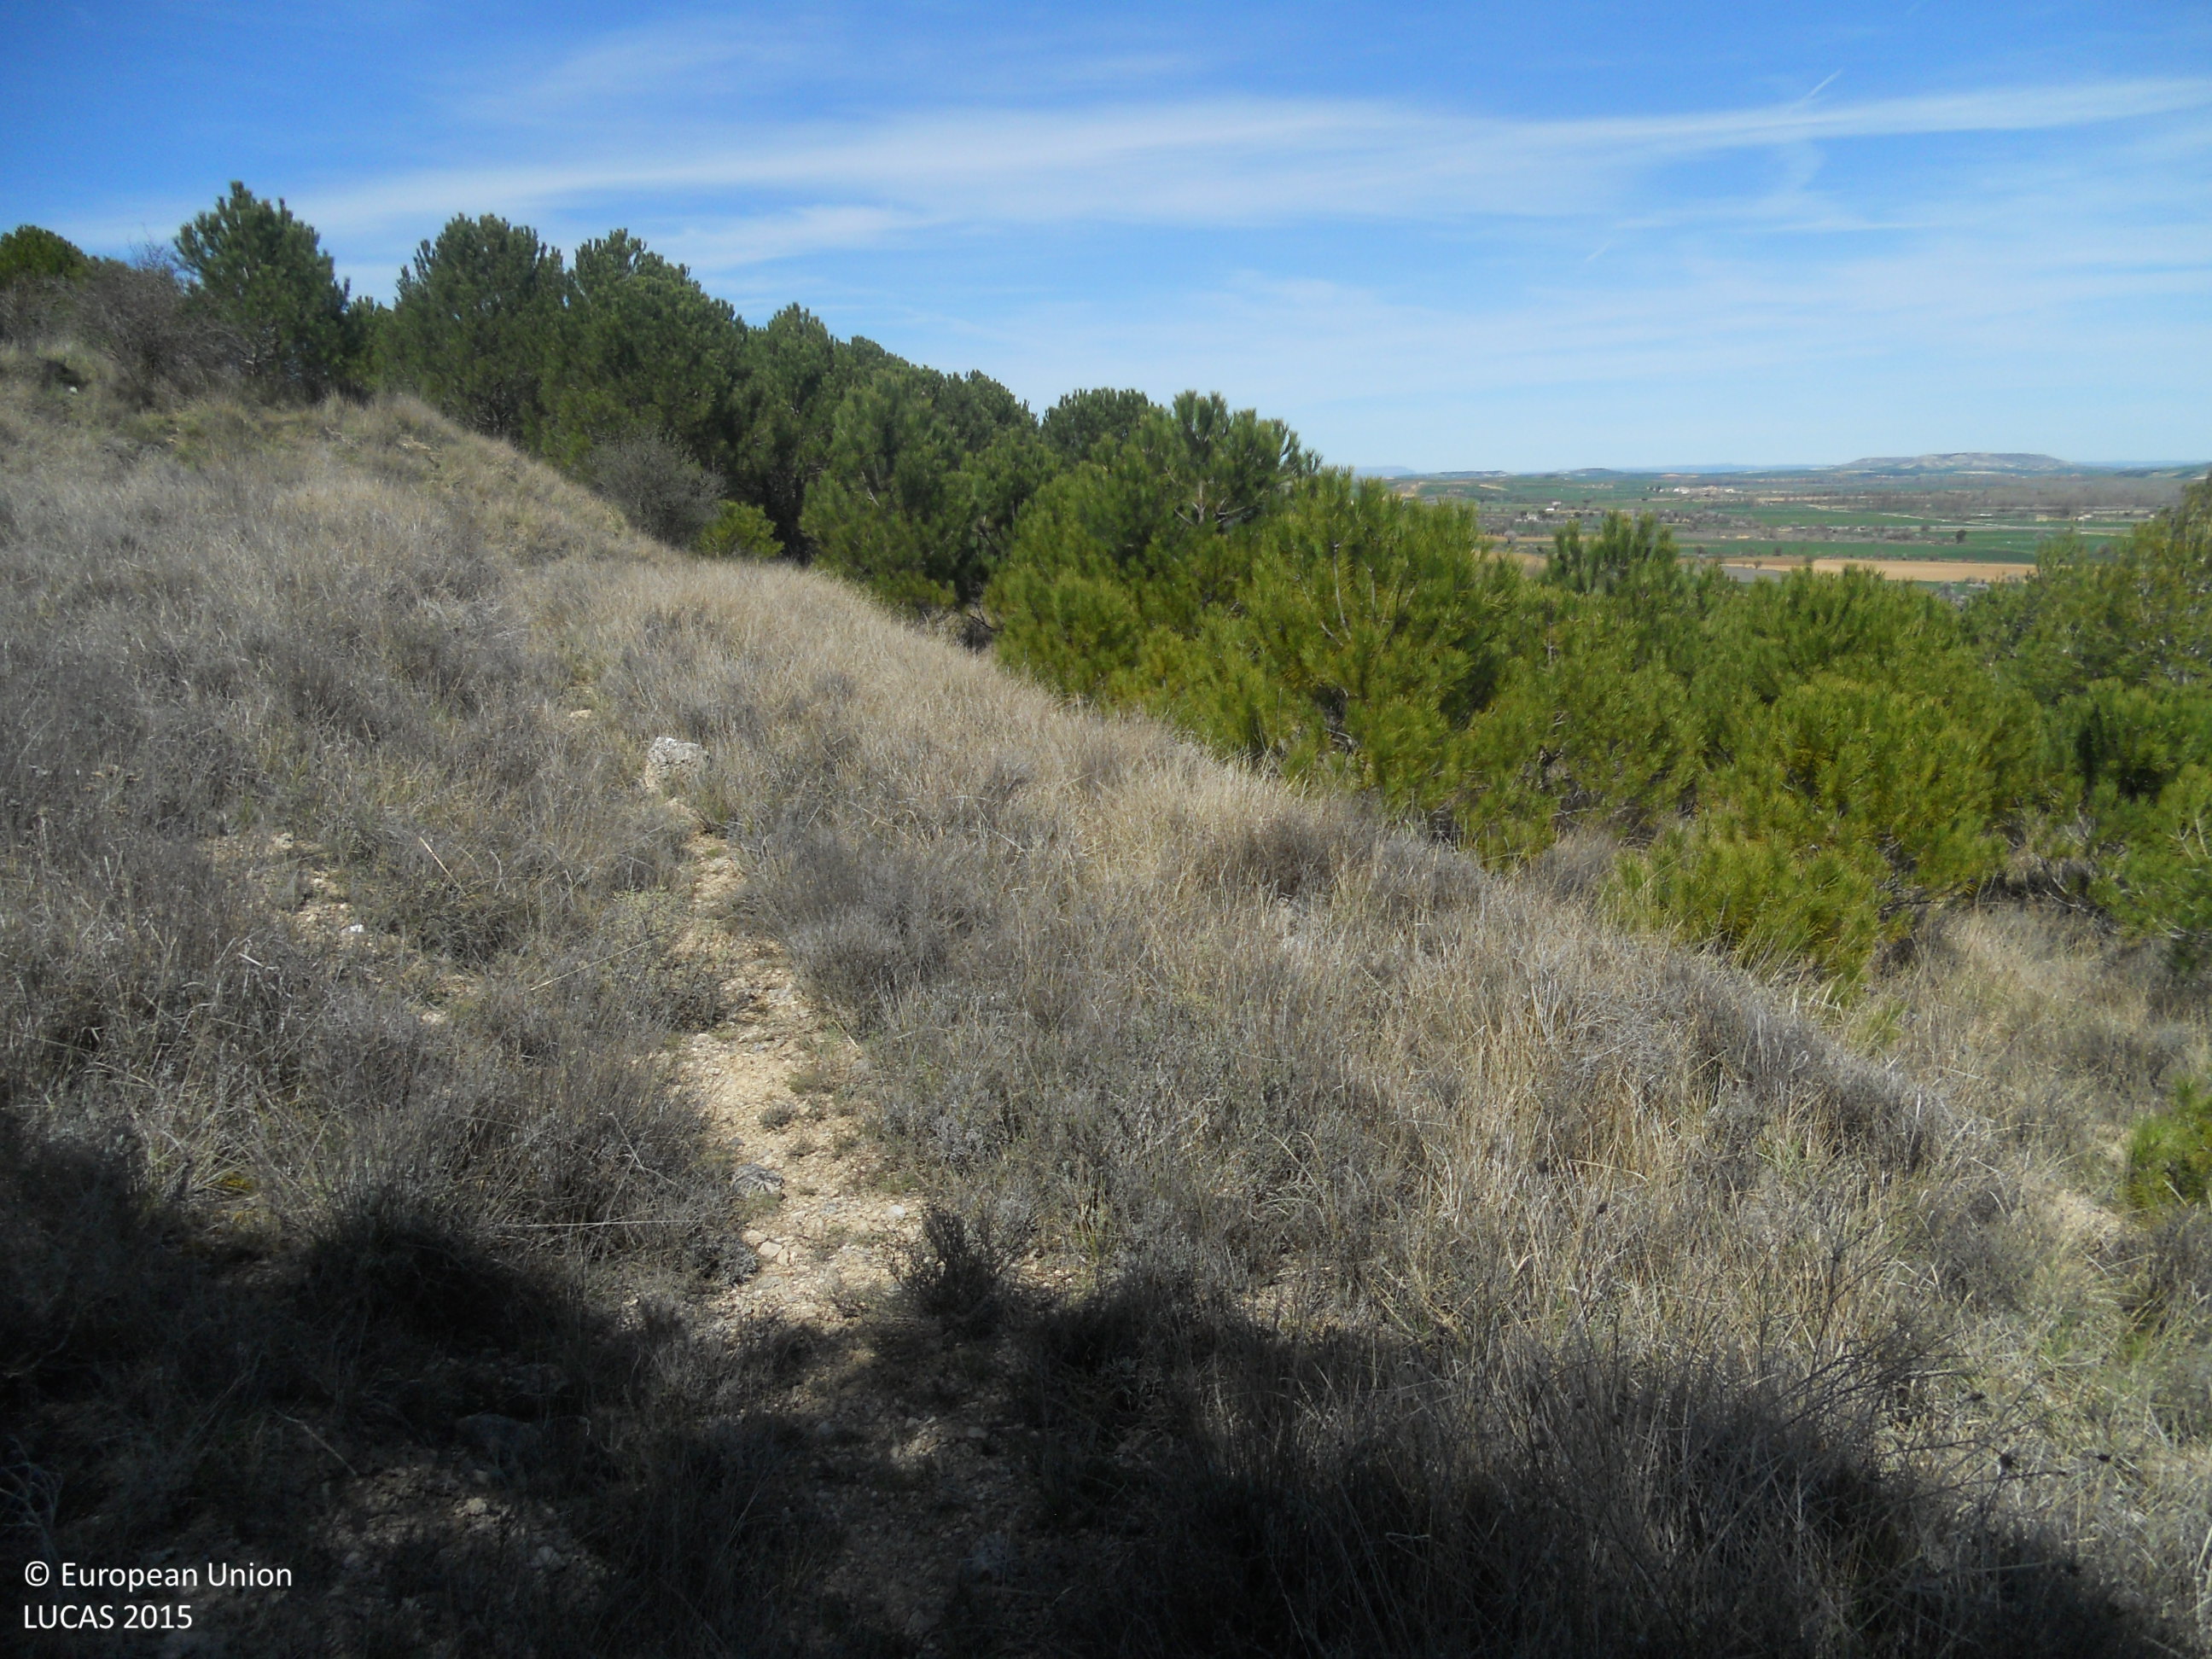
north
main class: Woodland
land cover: Pine dominated coniferous woodland
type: coniferous forest of the mediterranean region
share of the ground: 50 - 75 %
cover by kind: coniferous forest trees 65 %, herbaceous plants 20 %, shrubs 10 %, consolidated bare surface 5 %
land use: Forestry
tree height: > 5 m
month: April
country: ES
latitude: 42.1692
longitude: -4.2667
